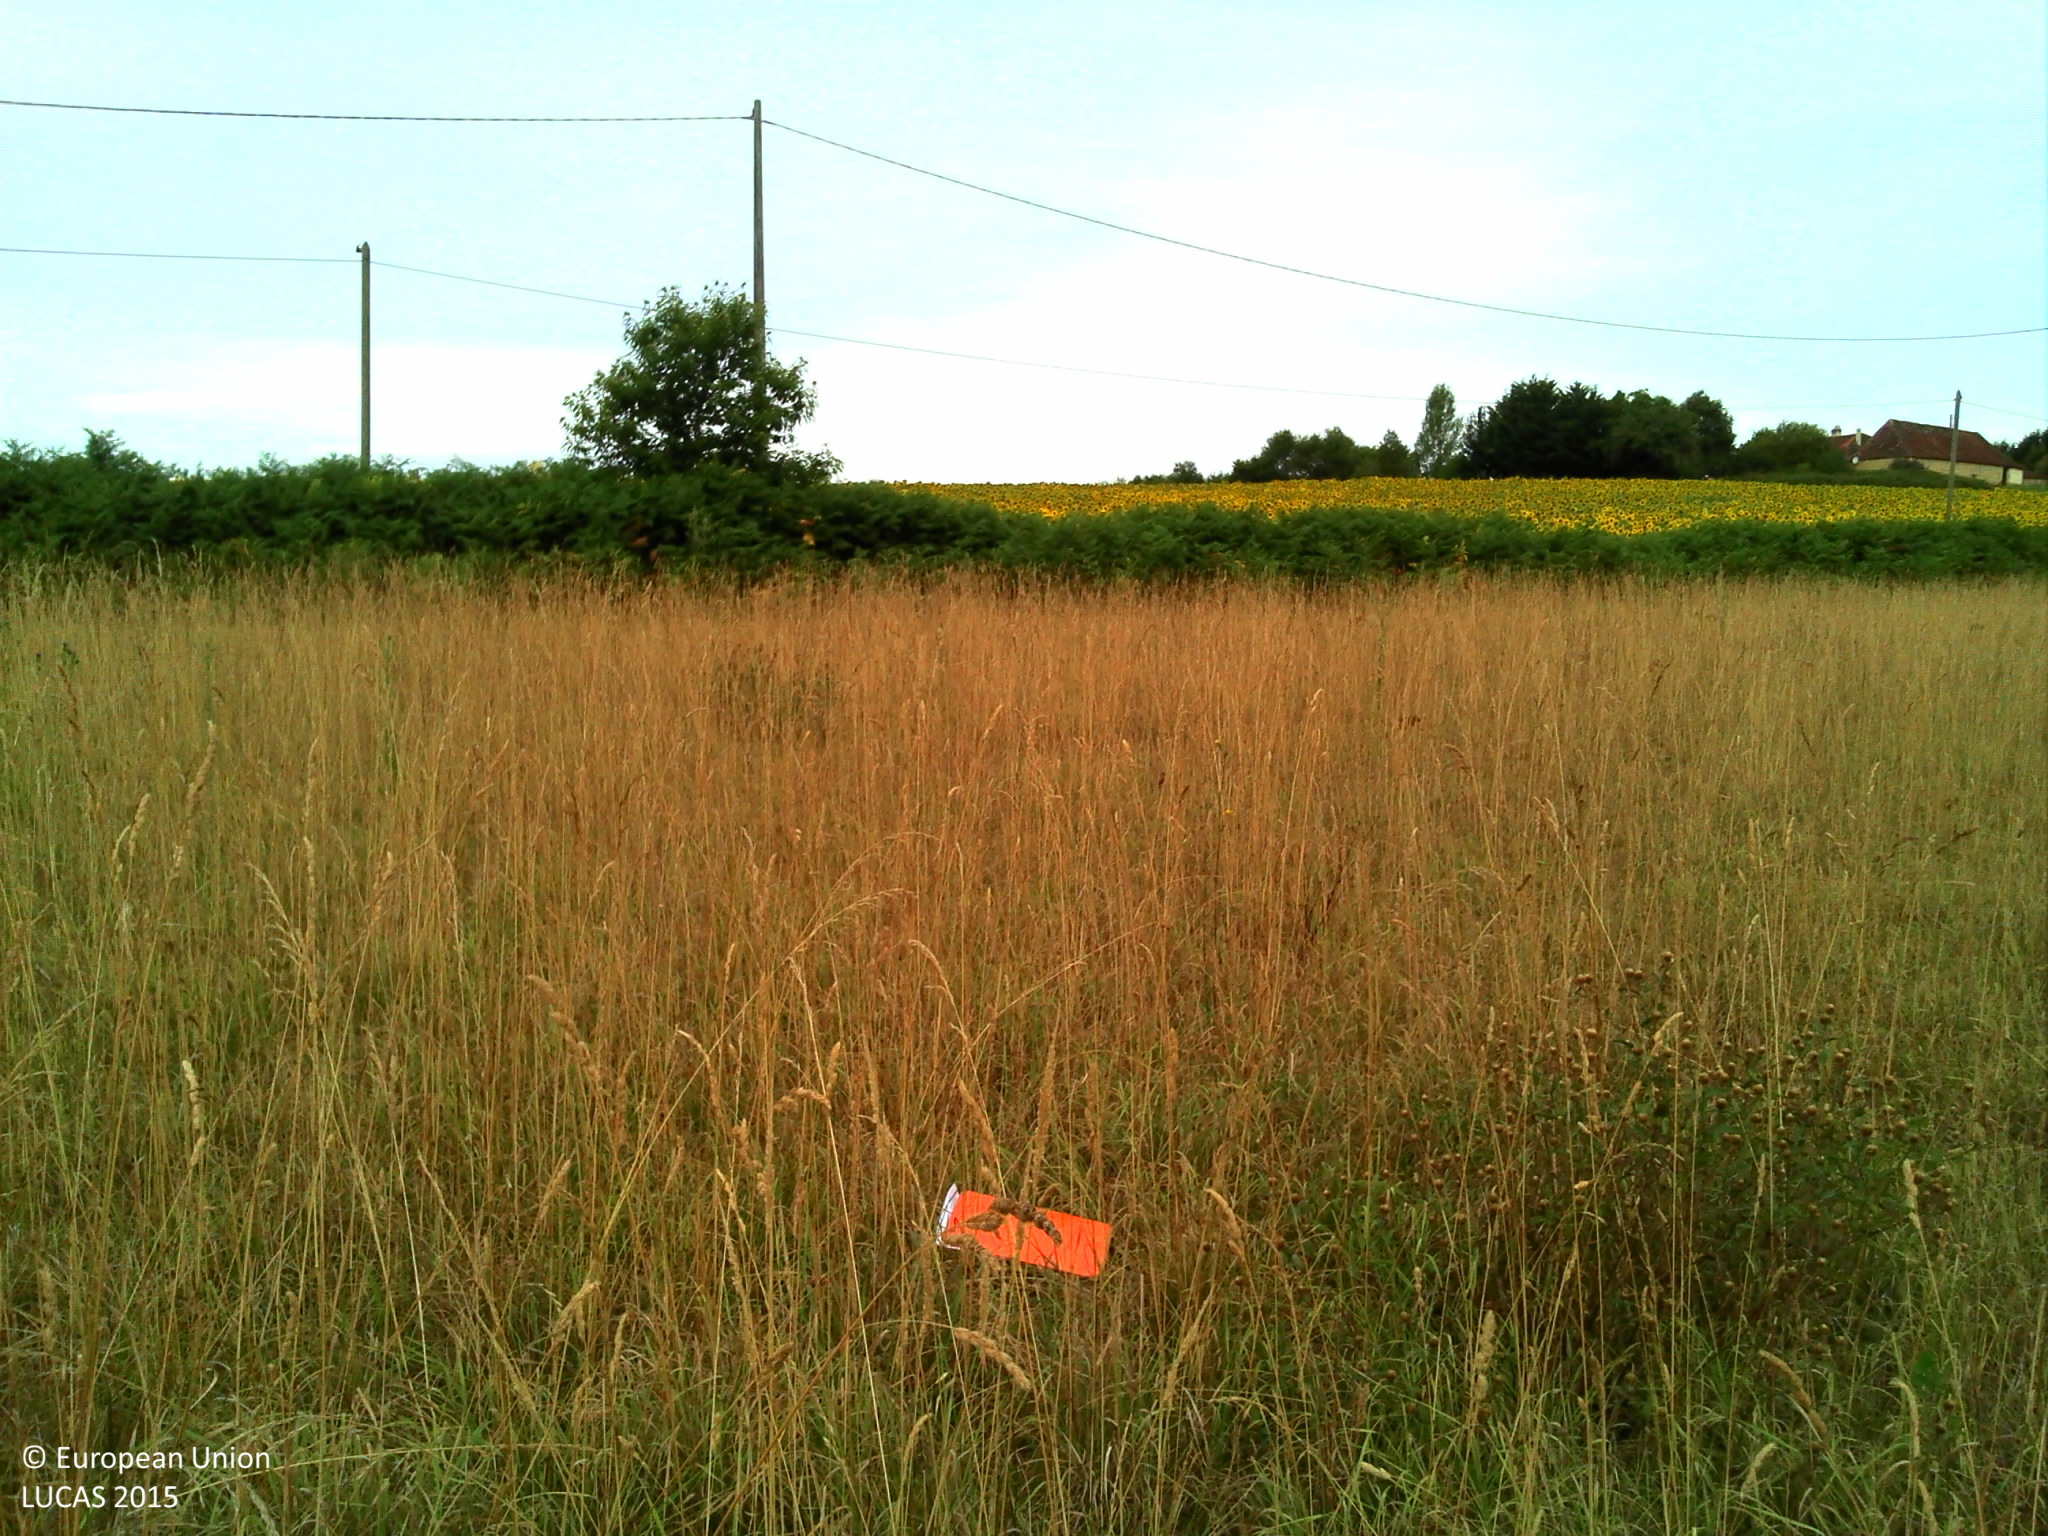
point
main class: Grassland
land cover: Grassland without tree/shrub cover
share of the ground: > 75 %
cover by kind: herbaceous plants 100 %
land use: Agriculture (excluding fallow land and kitchen gardens)
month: July
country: FR
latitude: 44.9771
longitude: 0.8236
